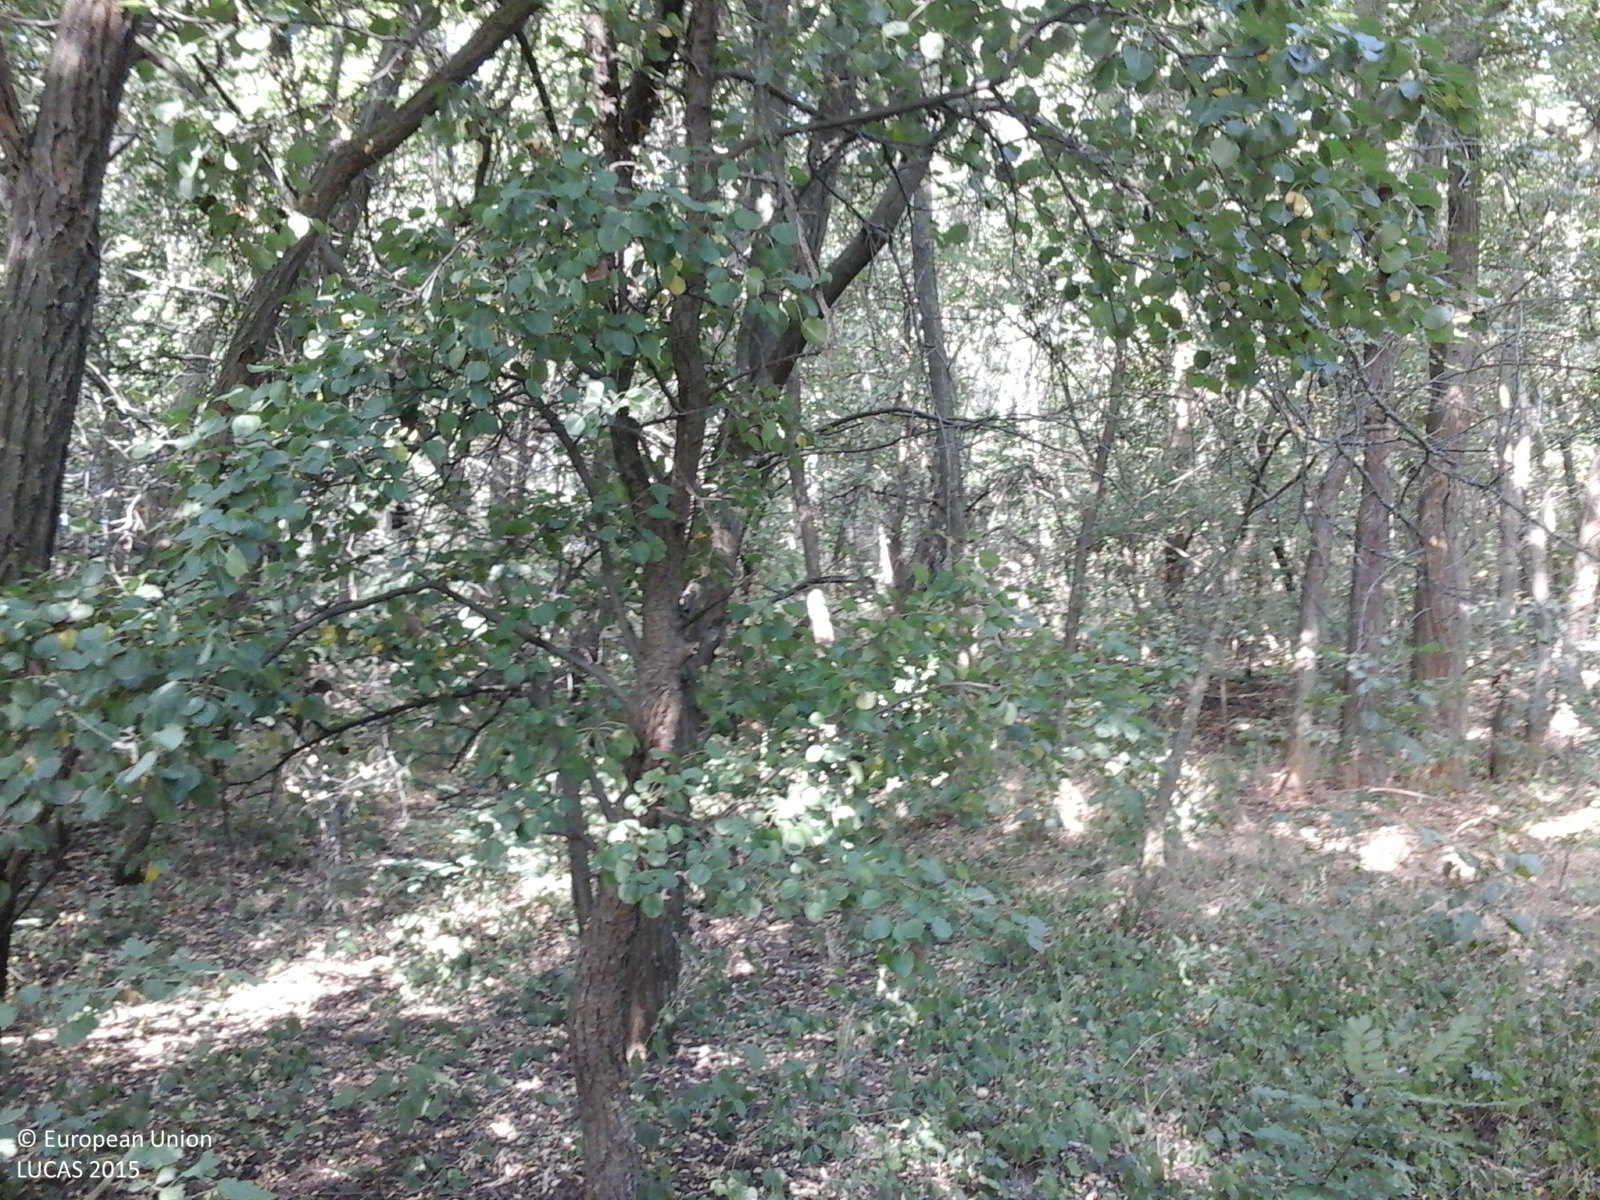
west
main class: Woodland
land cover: Broadleaved woodland
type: mesophytic deciduous forest
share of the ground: > 75 %
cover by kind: broadleaved forest trees 80 %, shrubs 10 %, herbaceous plants 10 %
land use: Forestry
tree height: > 5 m
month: July
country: RO
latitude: 46.1517
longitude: 27.5769
